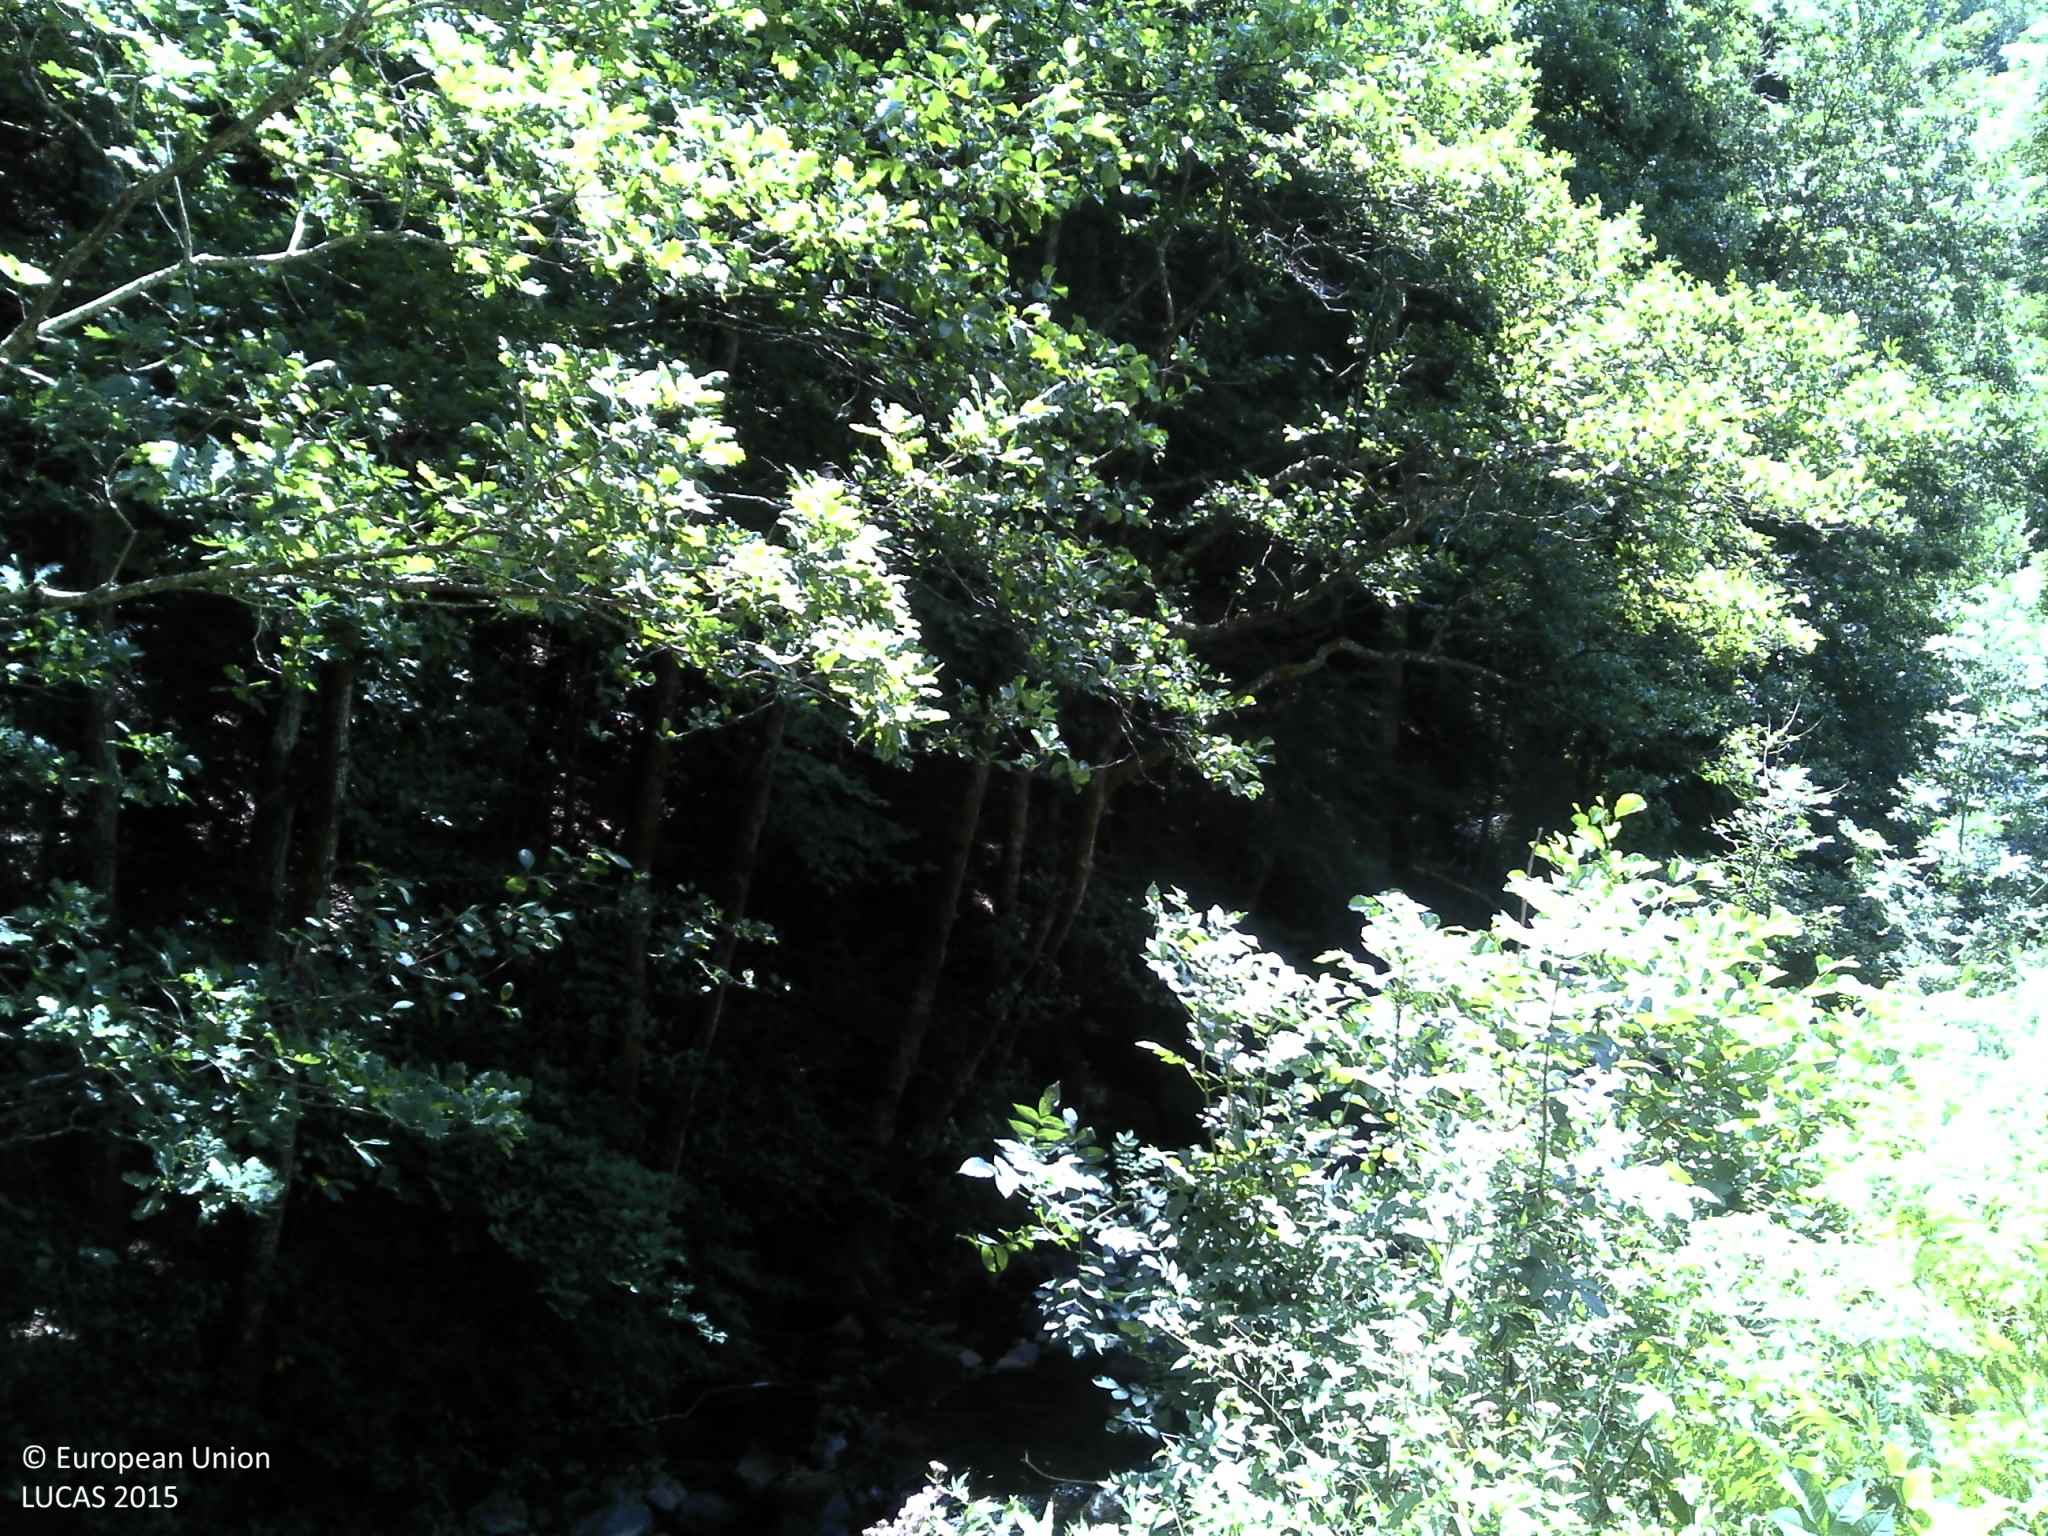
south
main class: Woodland
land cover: Spruce dominated mixed woodland
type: broadleaved evergreen forest
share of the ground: > 75 %
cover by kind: coniferous forest trees 40 %, broadleaved forest trees 20 %, herbaceous plants 20 %, shrubs 10 %, lichens and mosses 10 %
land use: Forestry
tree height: > 5 m
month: July
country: FR
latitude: 45.5528
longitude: 3.4301
